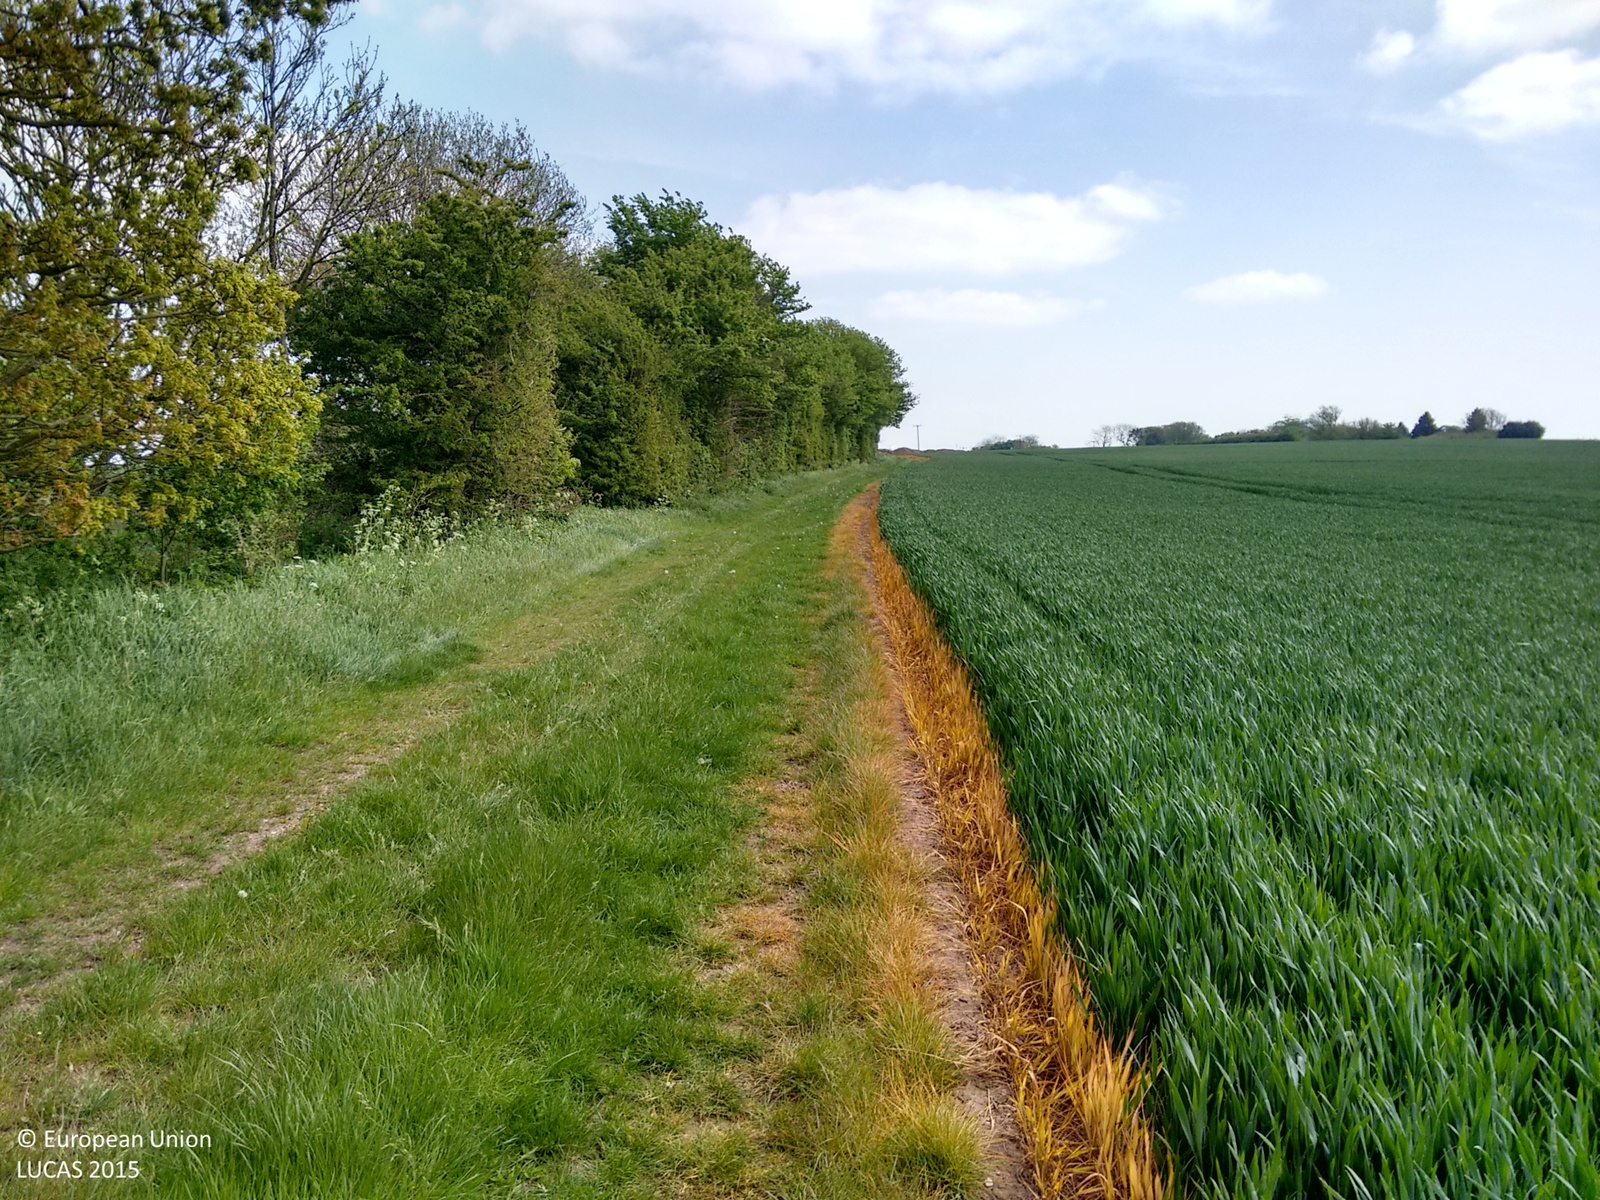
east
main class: Cropland
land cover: Common wheat
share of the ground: > 75 %
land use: Agriculture (excluding fallow land and kitchen gardens)
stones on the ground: < 10 %
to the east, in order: Common wheat; Grassland without tree/shrub cover; Broadleaved woodland; Grass margins; Common wheat; Electric lines; Common wheat; Tracks; Common wheat
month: May
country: GB
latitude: 53.6799
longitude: 0.0526
